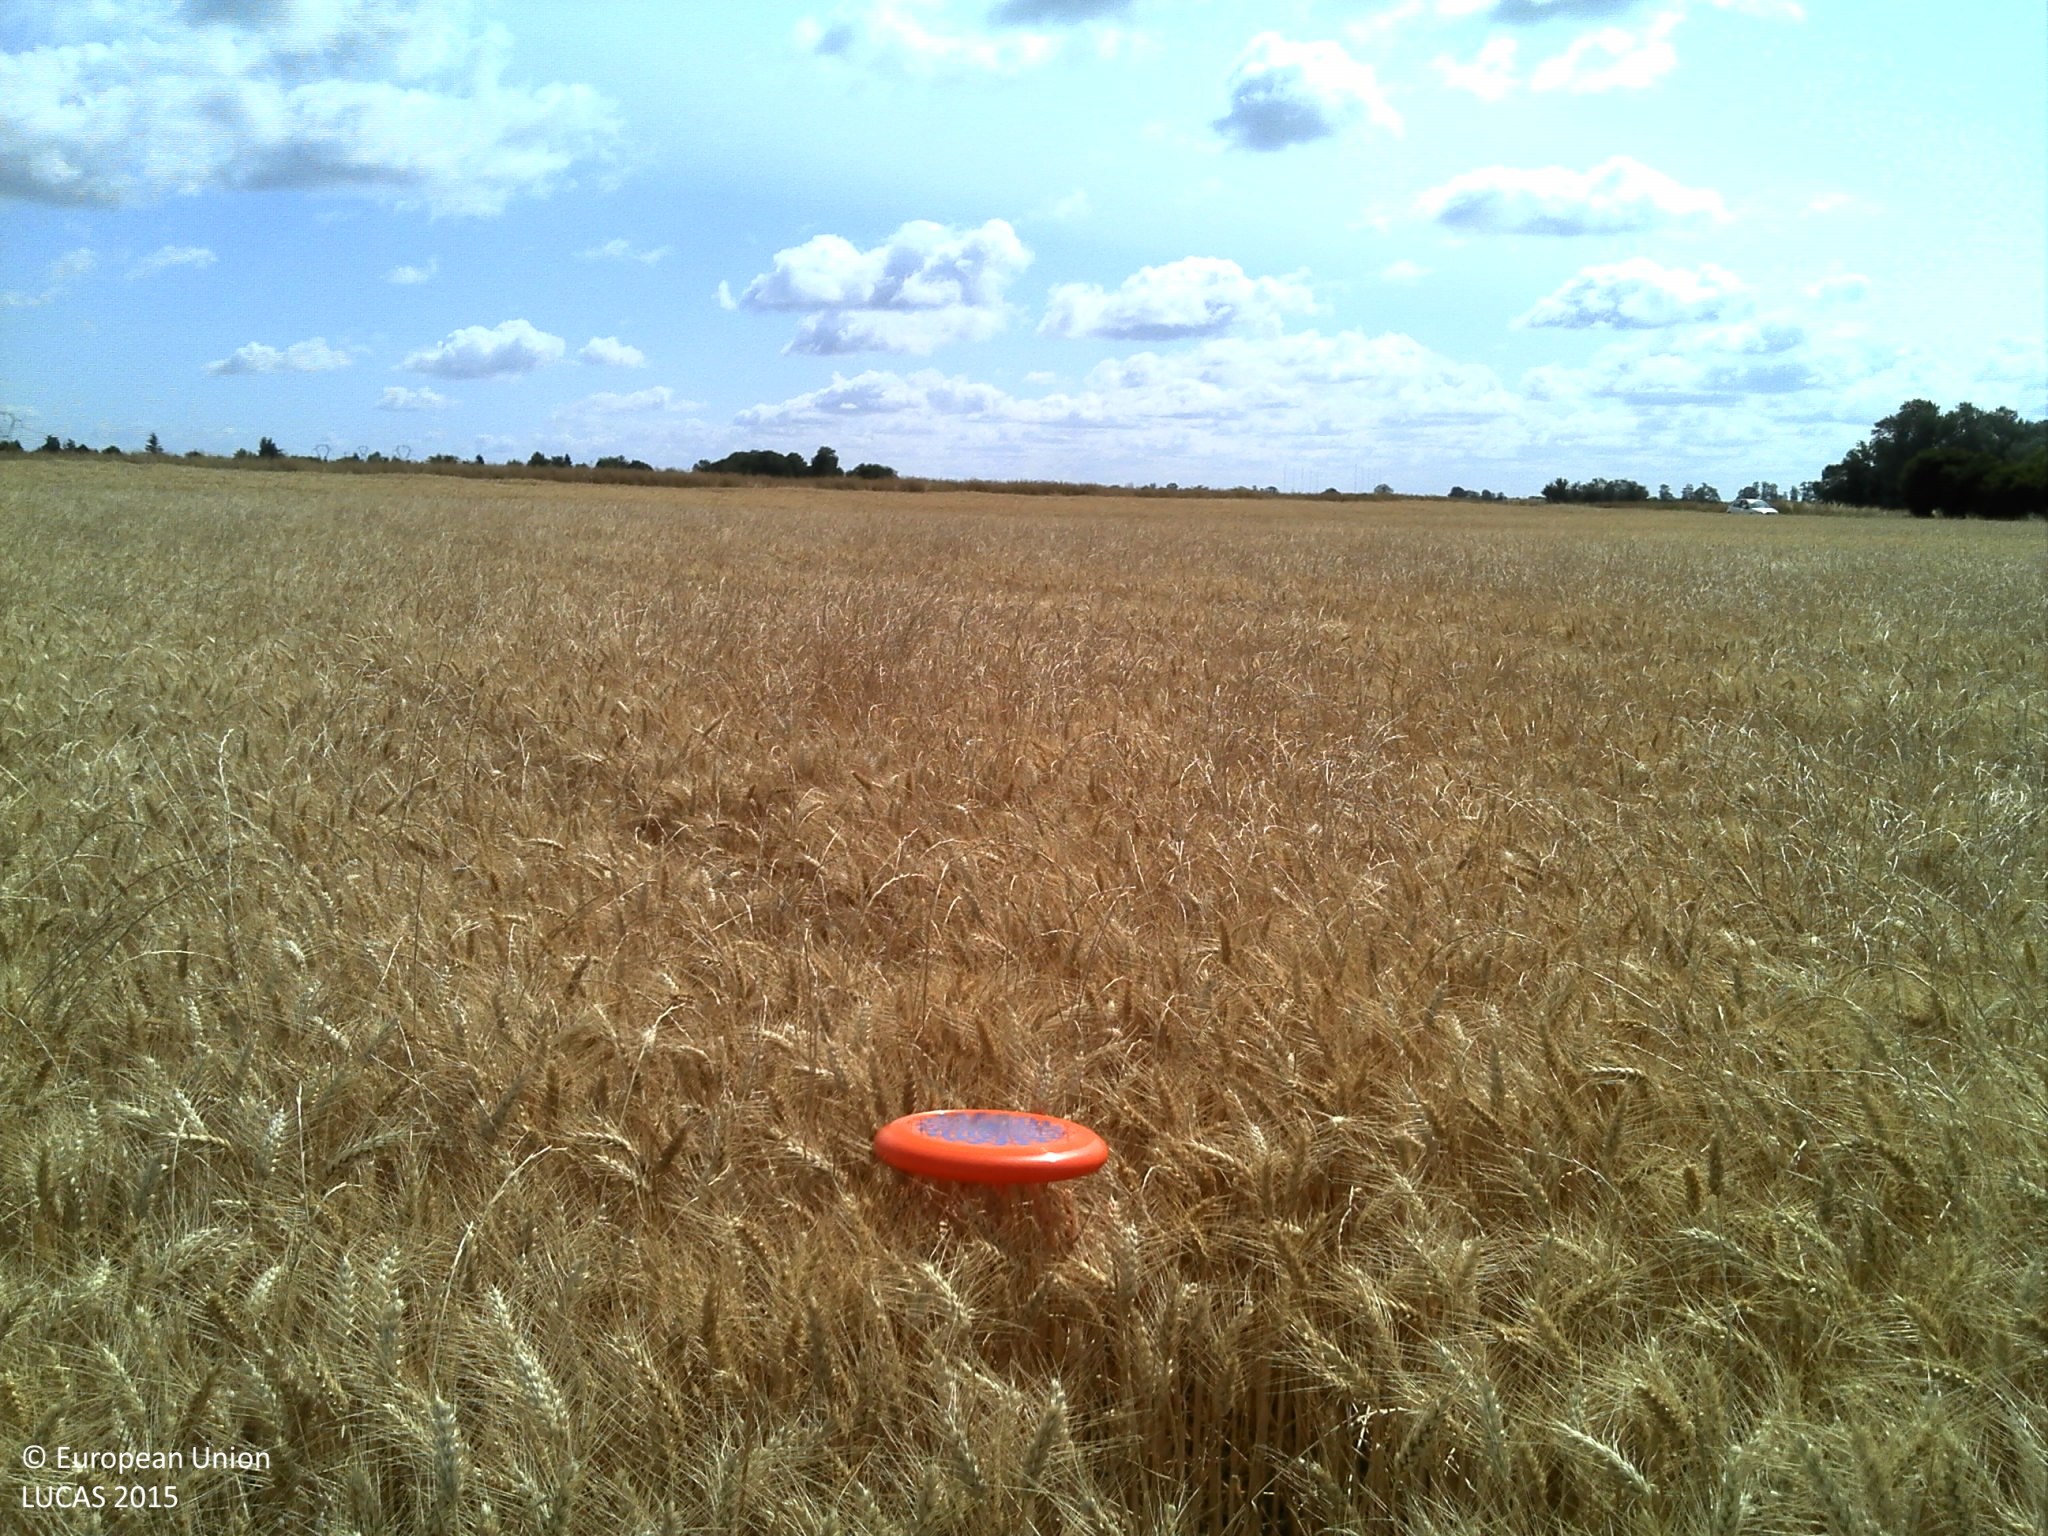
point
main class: Cropland
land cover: Durum wheat
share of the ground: > 75 %
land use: Agriculture (excluding fallow land and kitchen gardens)
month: July
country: FR
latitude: 48.5405
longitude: 2.4175
